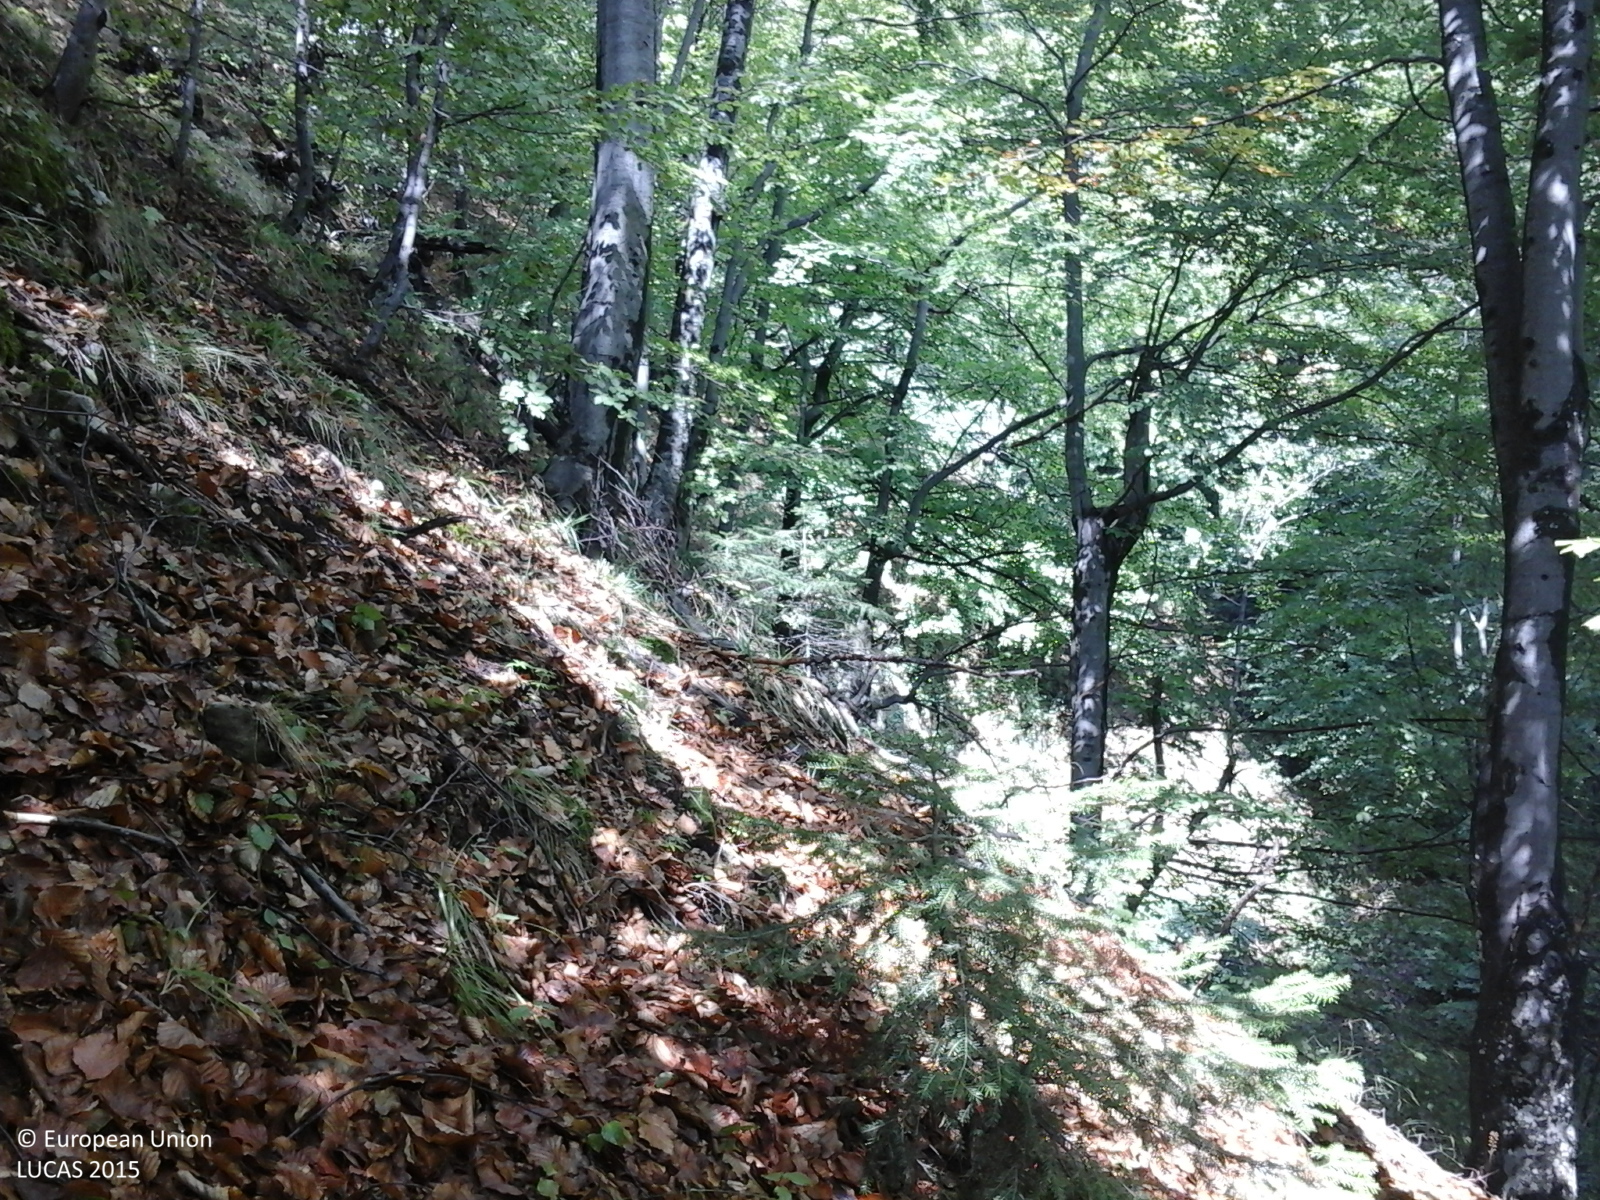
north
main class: Woodland
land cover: Broadleaved woodland
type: beech forest
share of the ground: > 75 %
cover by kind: broadleaved forest trees 100 %
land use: Forestry
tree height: > 5 m
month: September
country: RO
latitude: 45.2612
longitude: 23.2968
